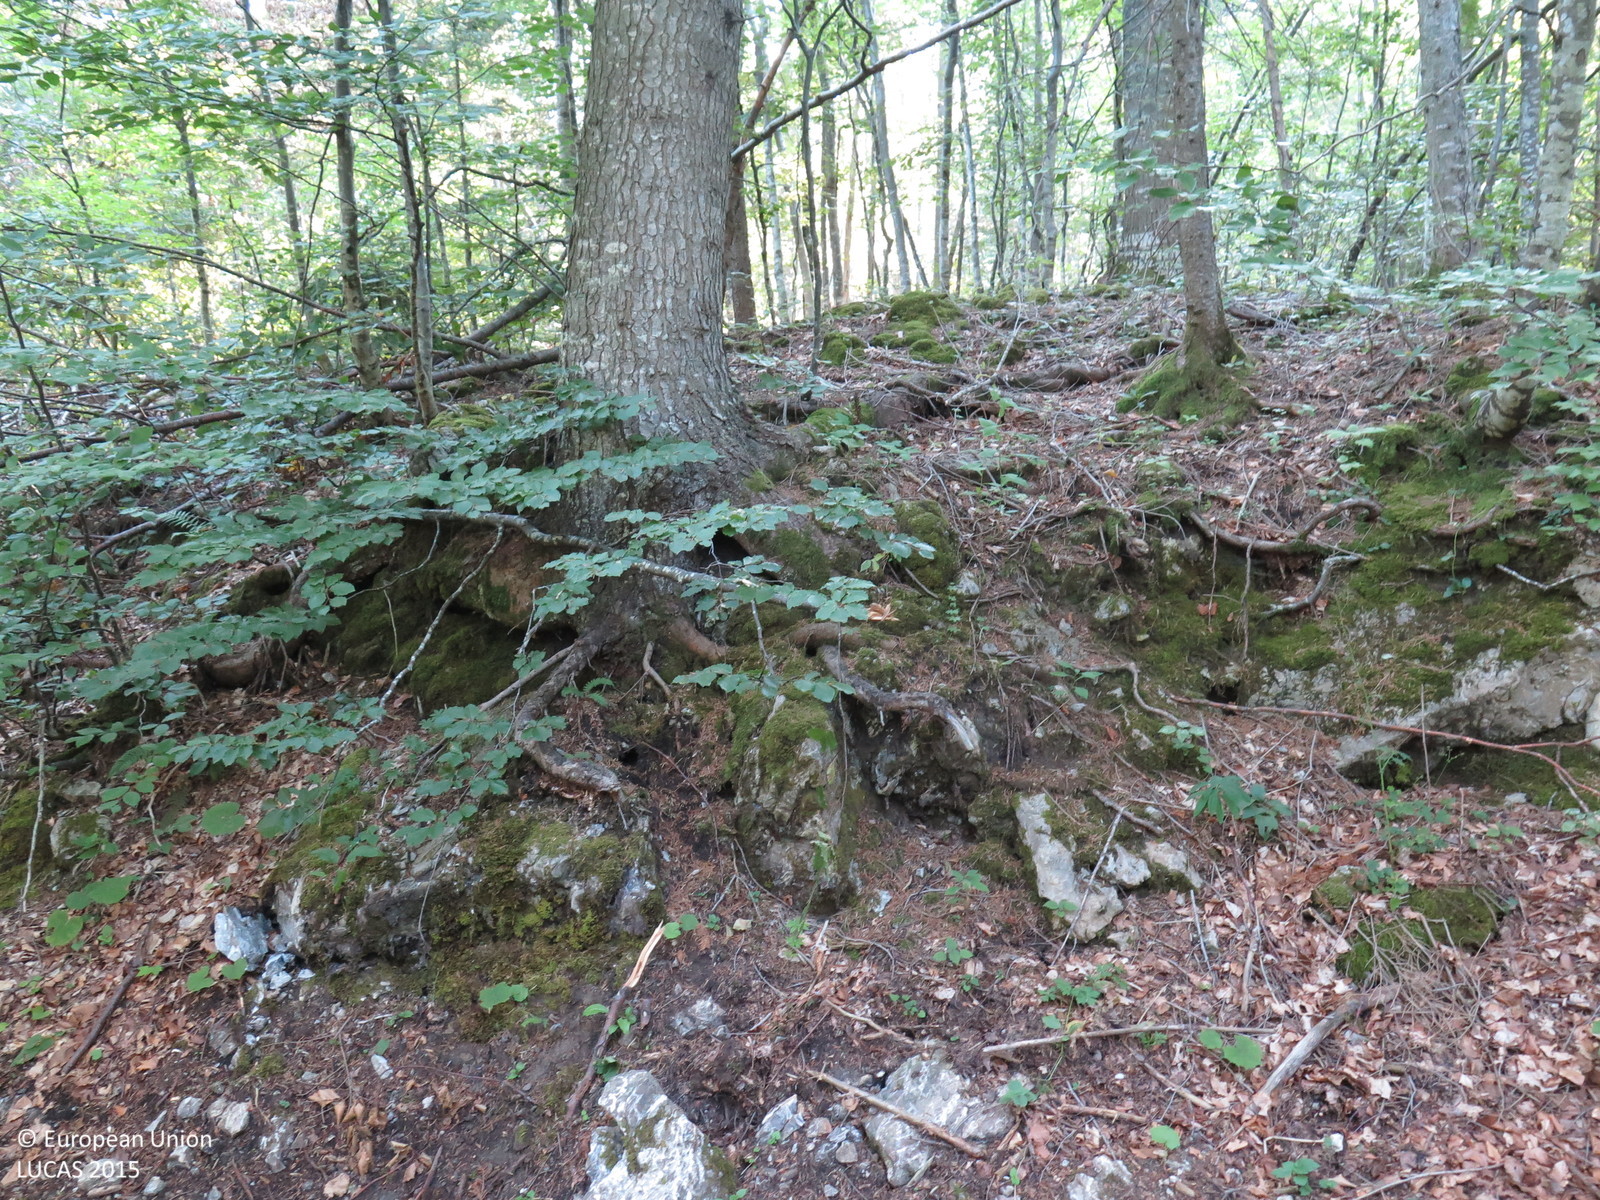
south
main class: Woodland
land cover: Other mixed woodland
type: mountainous beech forest
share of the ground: > 75 %
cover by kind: broadleaved forest trees 75 %, coniferous forest trees 25 %
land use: Forestry
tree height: > 5 m
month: September
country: HR
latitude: 45.5488
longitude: 14.5938
